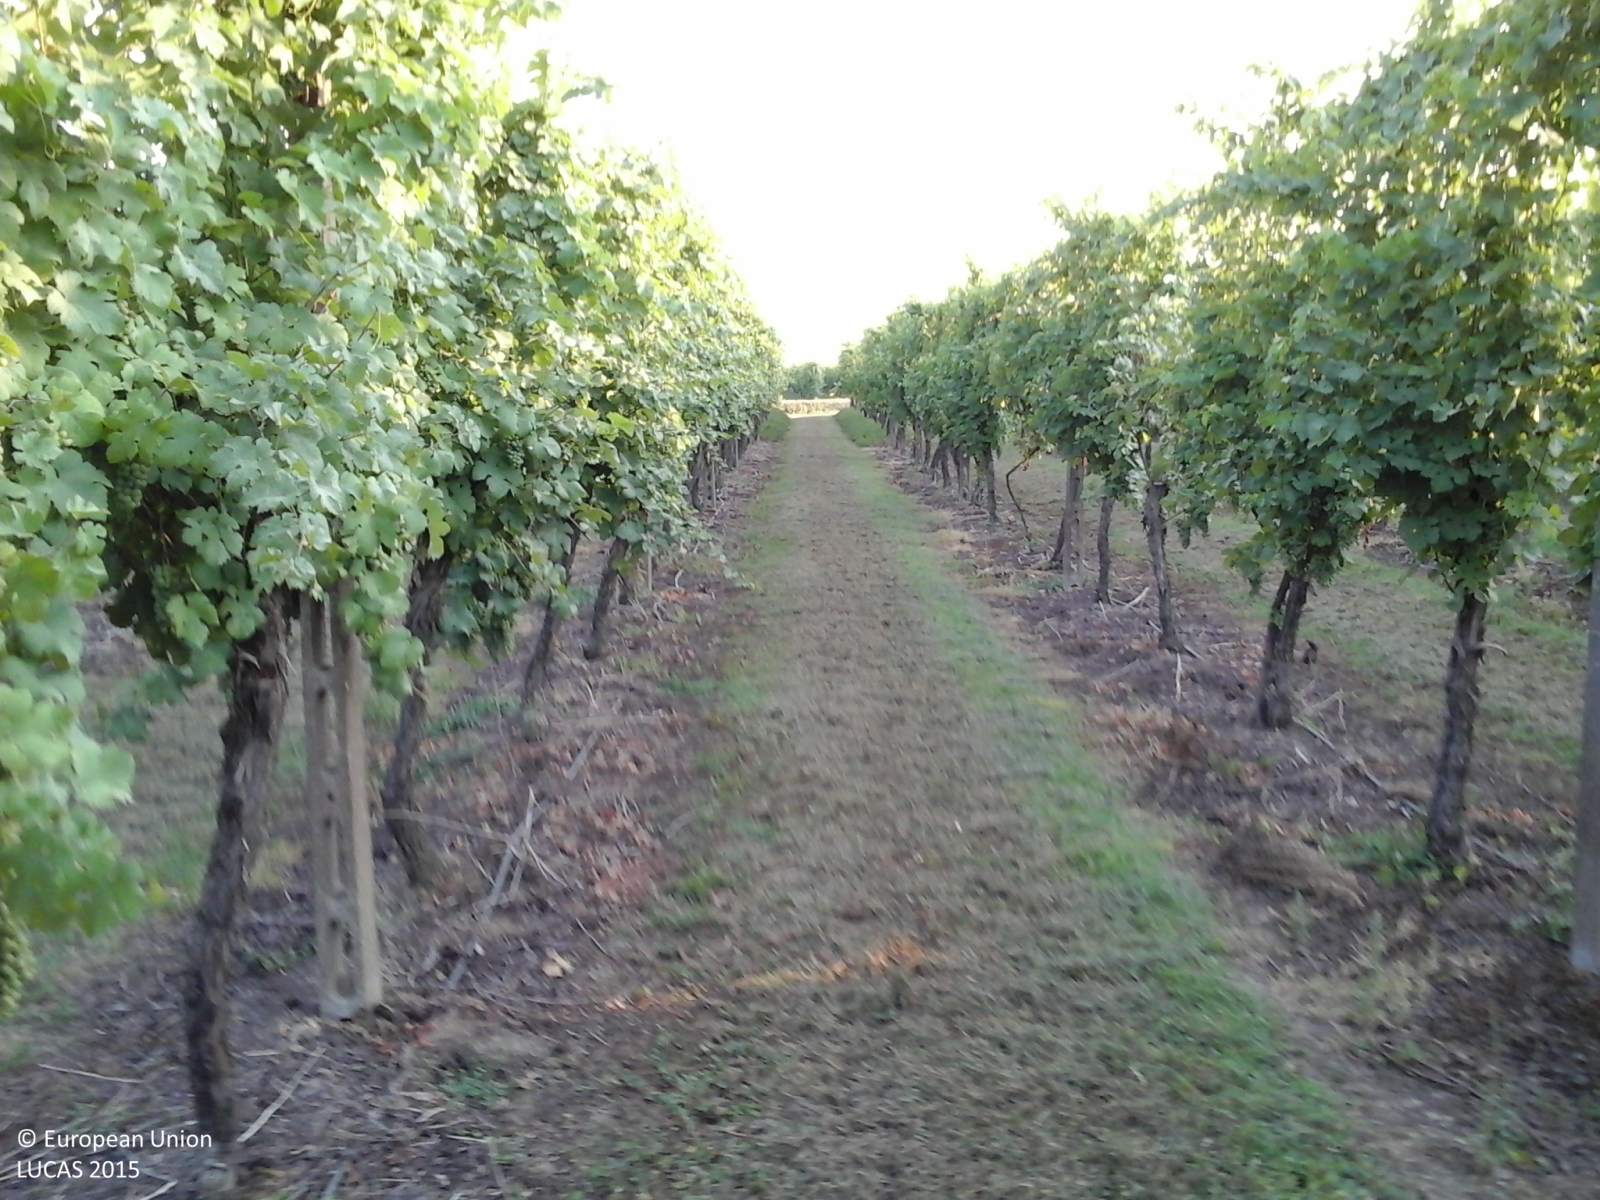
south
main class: Cropland
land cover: Vineyards
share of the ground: 25 - 50 %
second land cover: Spontaneously vegetated surfaces
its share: > 75 %
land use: Agriculture (excluding fallow land and kitchen gardens)
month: July
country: IT
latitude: 44.3690
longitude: 11.9158
